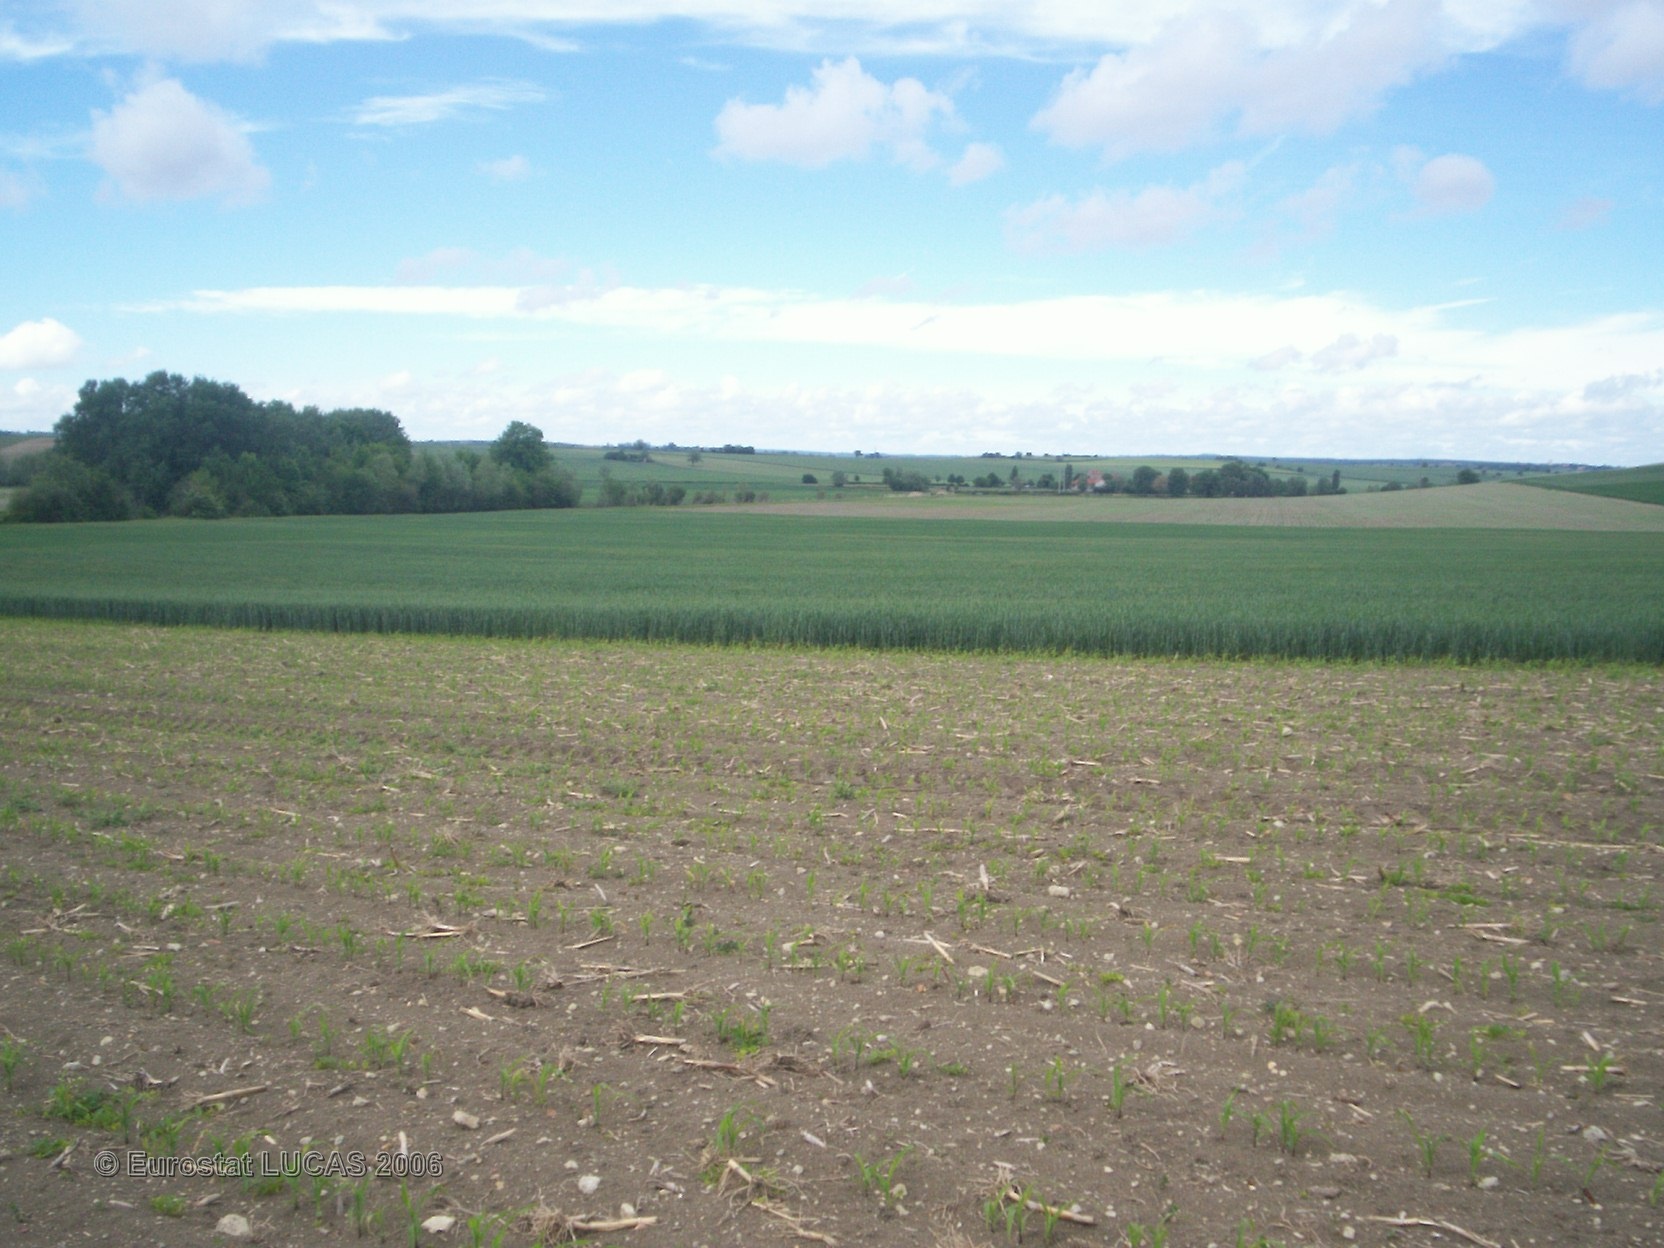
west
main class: Cropland
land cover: Maize
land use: Agriculture (excluding fallow land and kitchen gardens)
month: May
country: FR
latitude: 46.1838
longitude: 3.1192
